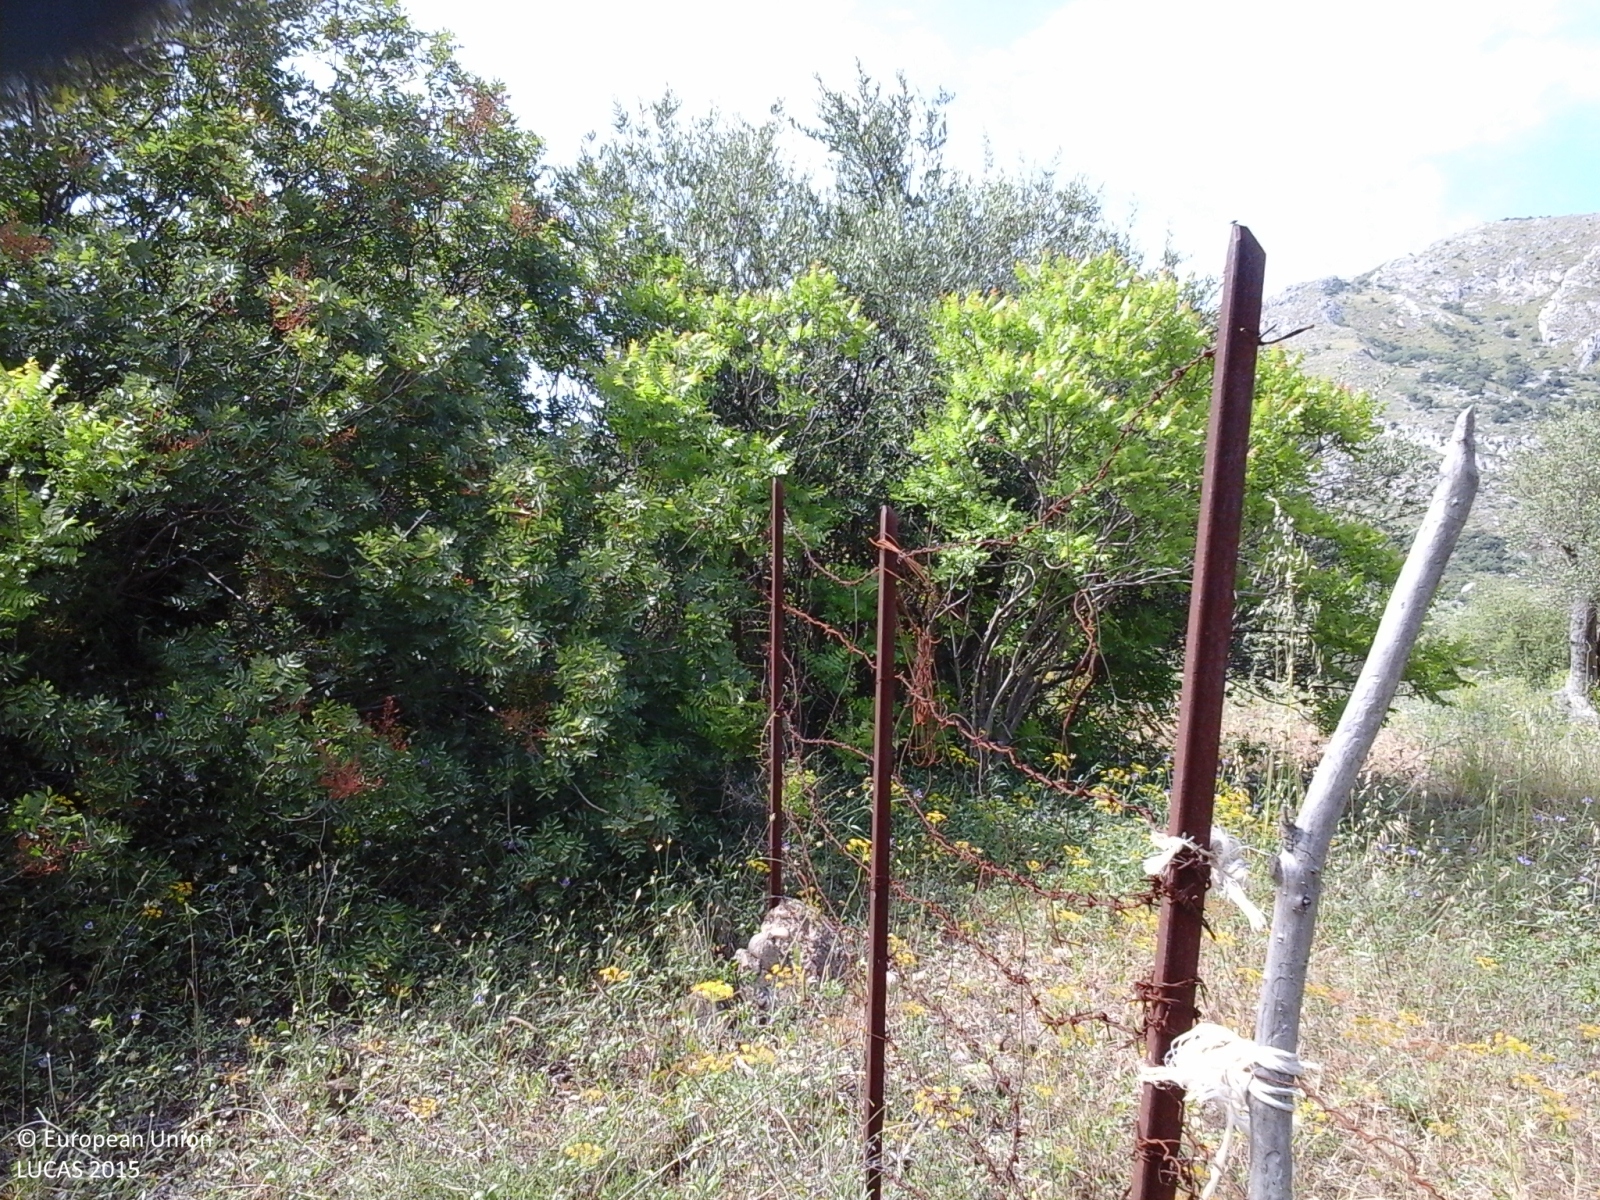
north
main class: Cropland
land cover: Olive groves
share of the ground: 25 - 50 %
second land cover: Spontaneously vegetated surfaces
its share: > 75 %
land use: Agriculture (excluding fallow land and kitchen gardens)
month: May
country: IT
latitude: 37.9163
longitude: 13.5803
